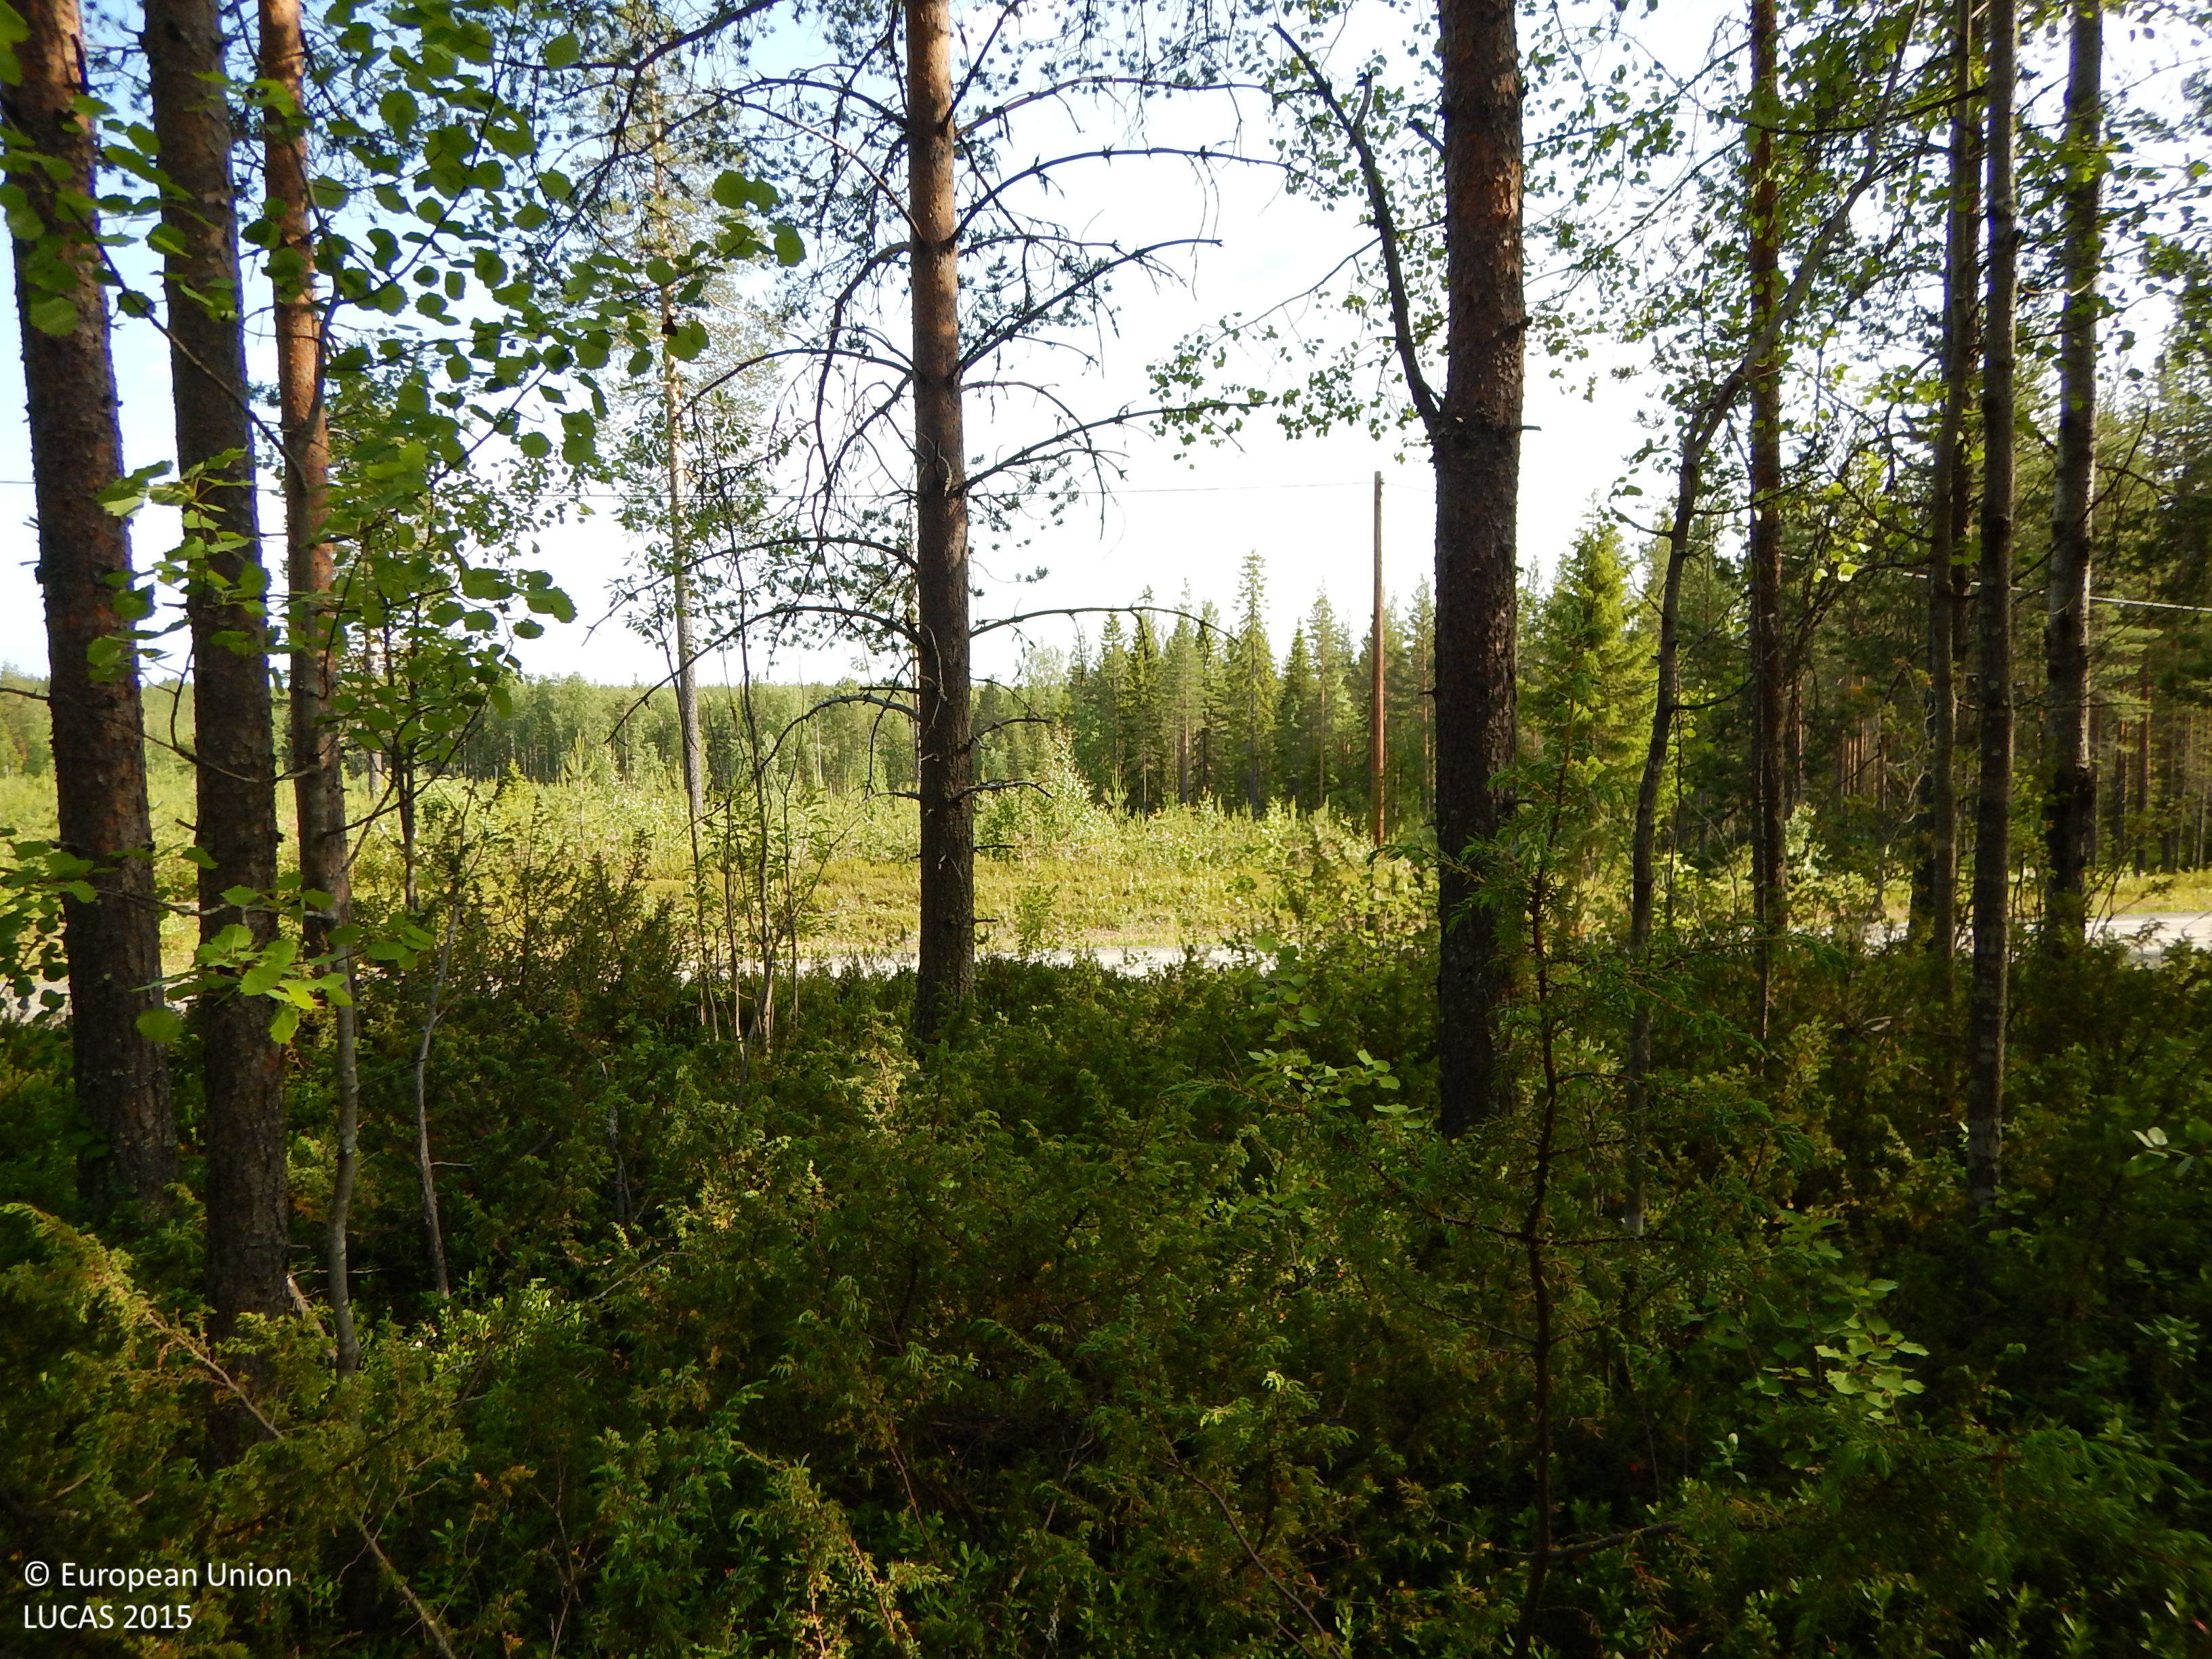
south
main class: Woodland
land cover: Pine dominated coniferous woodland
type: boreal forest
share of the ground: 50 - 75 %
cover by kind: coniferous forest trees 50 %, shrubs 20 %, broadleaved forest trees 10 %, herbaceous plants 10 %, lichens and mosses 10 %
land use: Forestry
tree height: > 5 m
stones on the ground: < 10 %
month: July
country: SE
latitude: 65.0038
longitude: 20.1294
